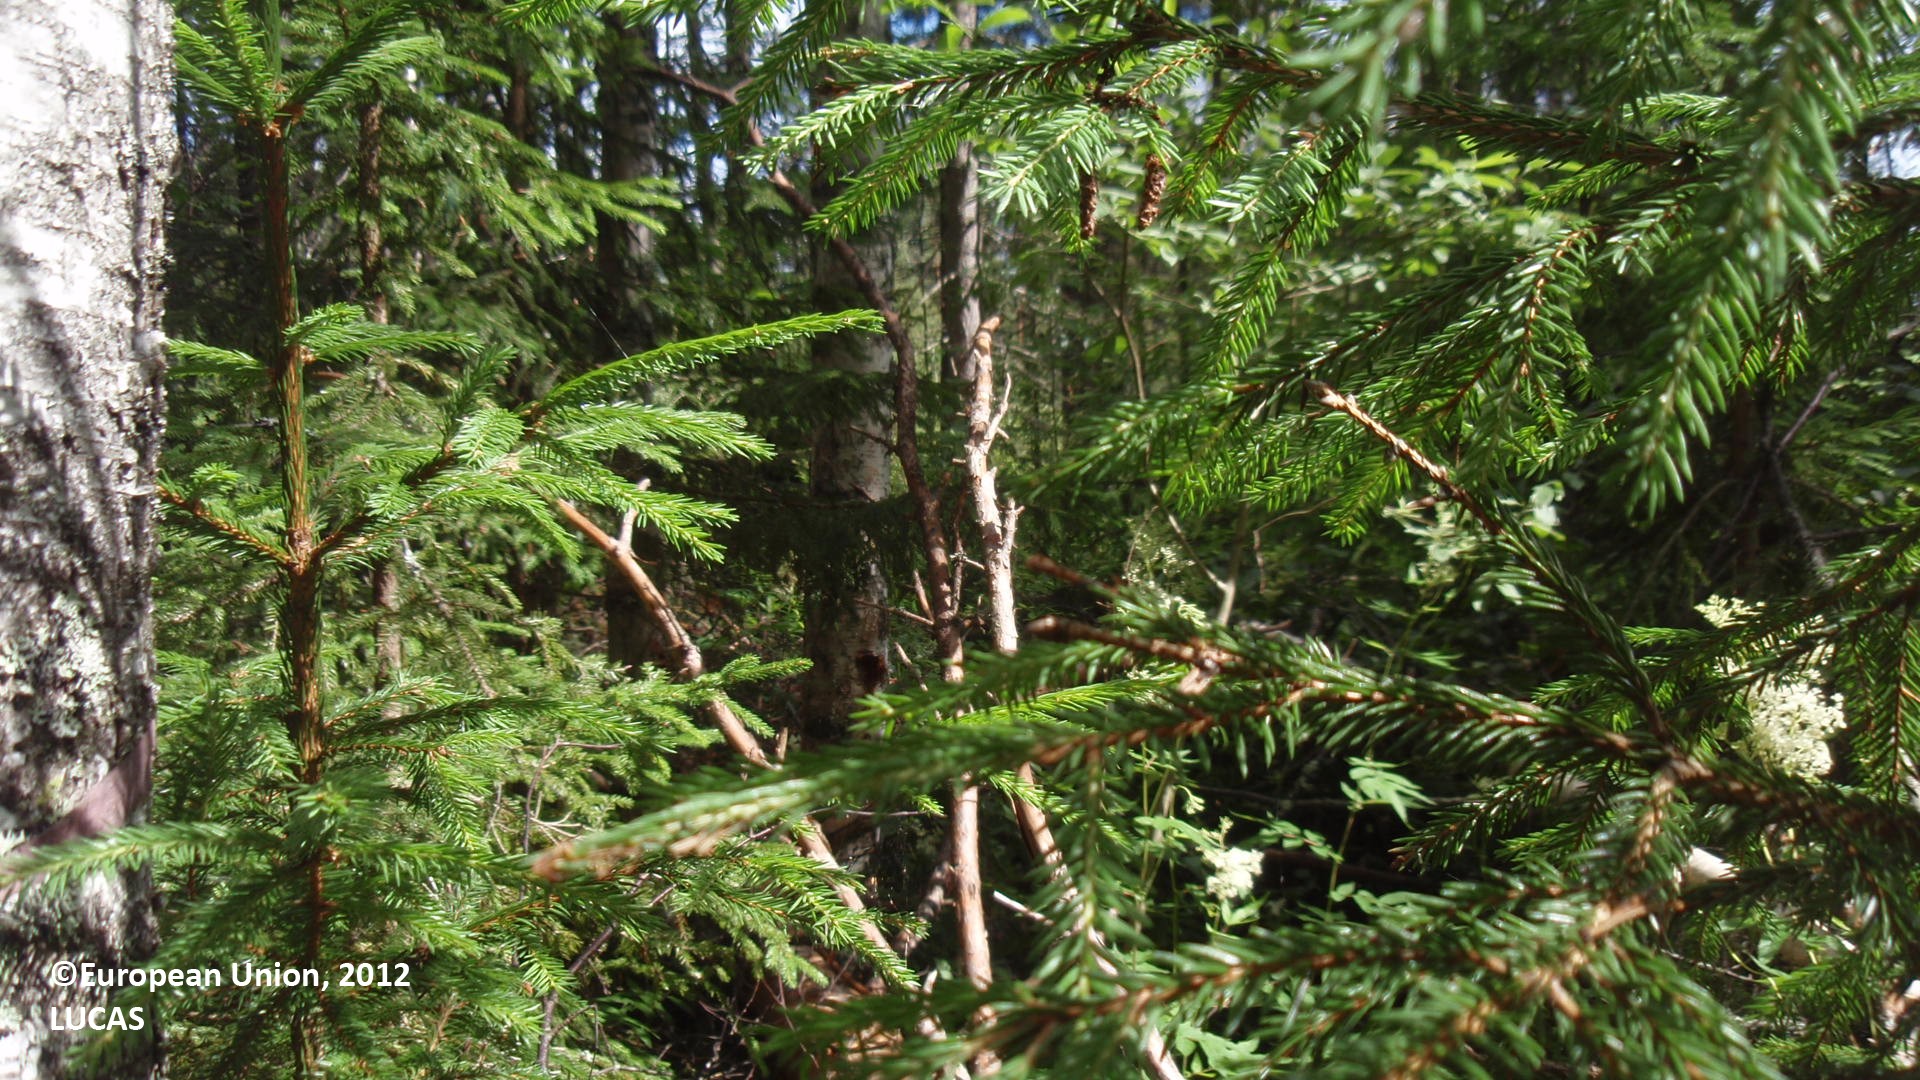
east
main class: Woodland
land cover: Spruce dominated mixed woodland
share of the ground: 50 - 75 %
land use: Forestry
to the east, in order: Spruce dominated mixed woodland; Spruce dominated coniferous woodland; Shrubland with sparse tree cover; Spruce dominated coniferous woodland; Inland marshes; Shrubland with sparse tree cover
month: July
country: FI
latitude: 61.6371
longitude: 27.4402
